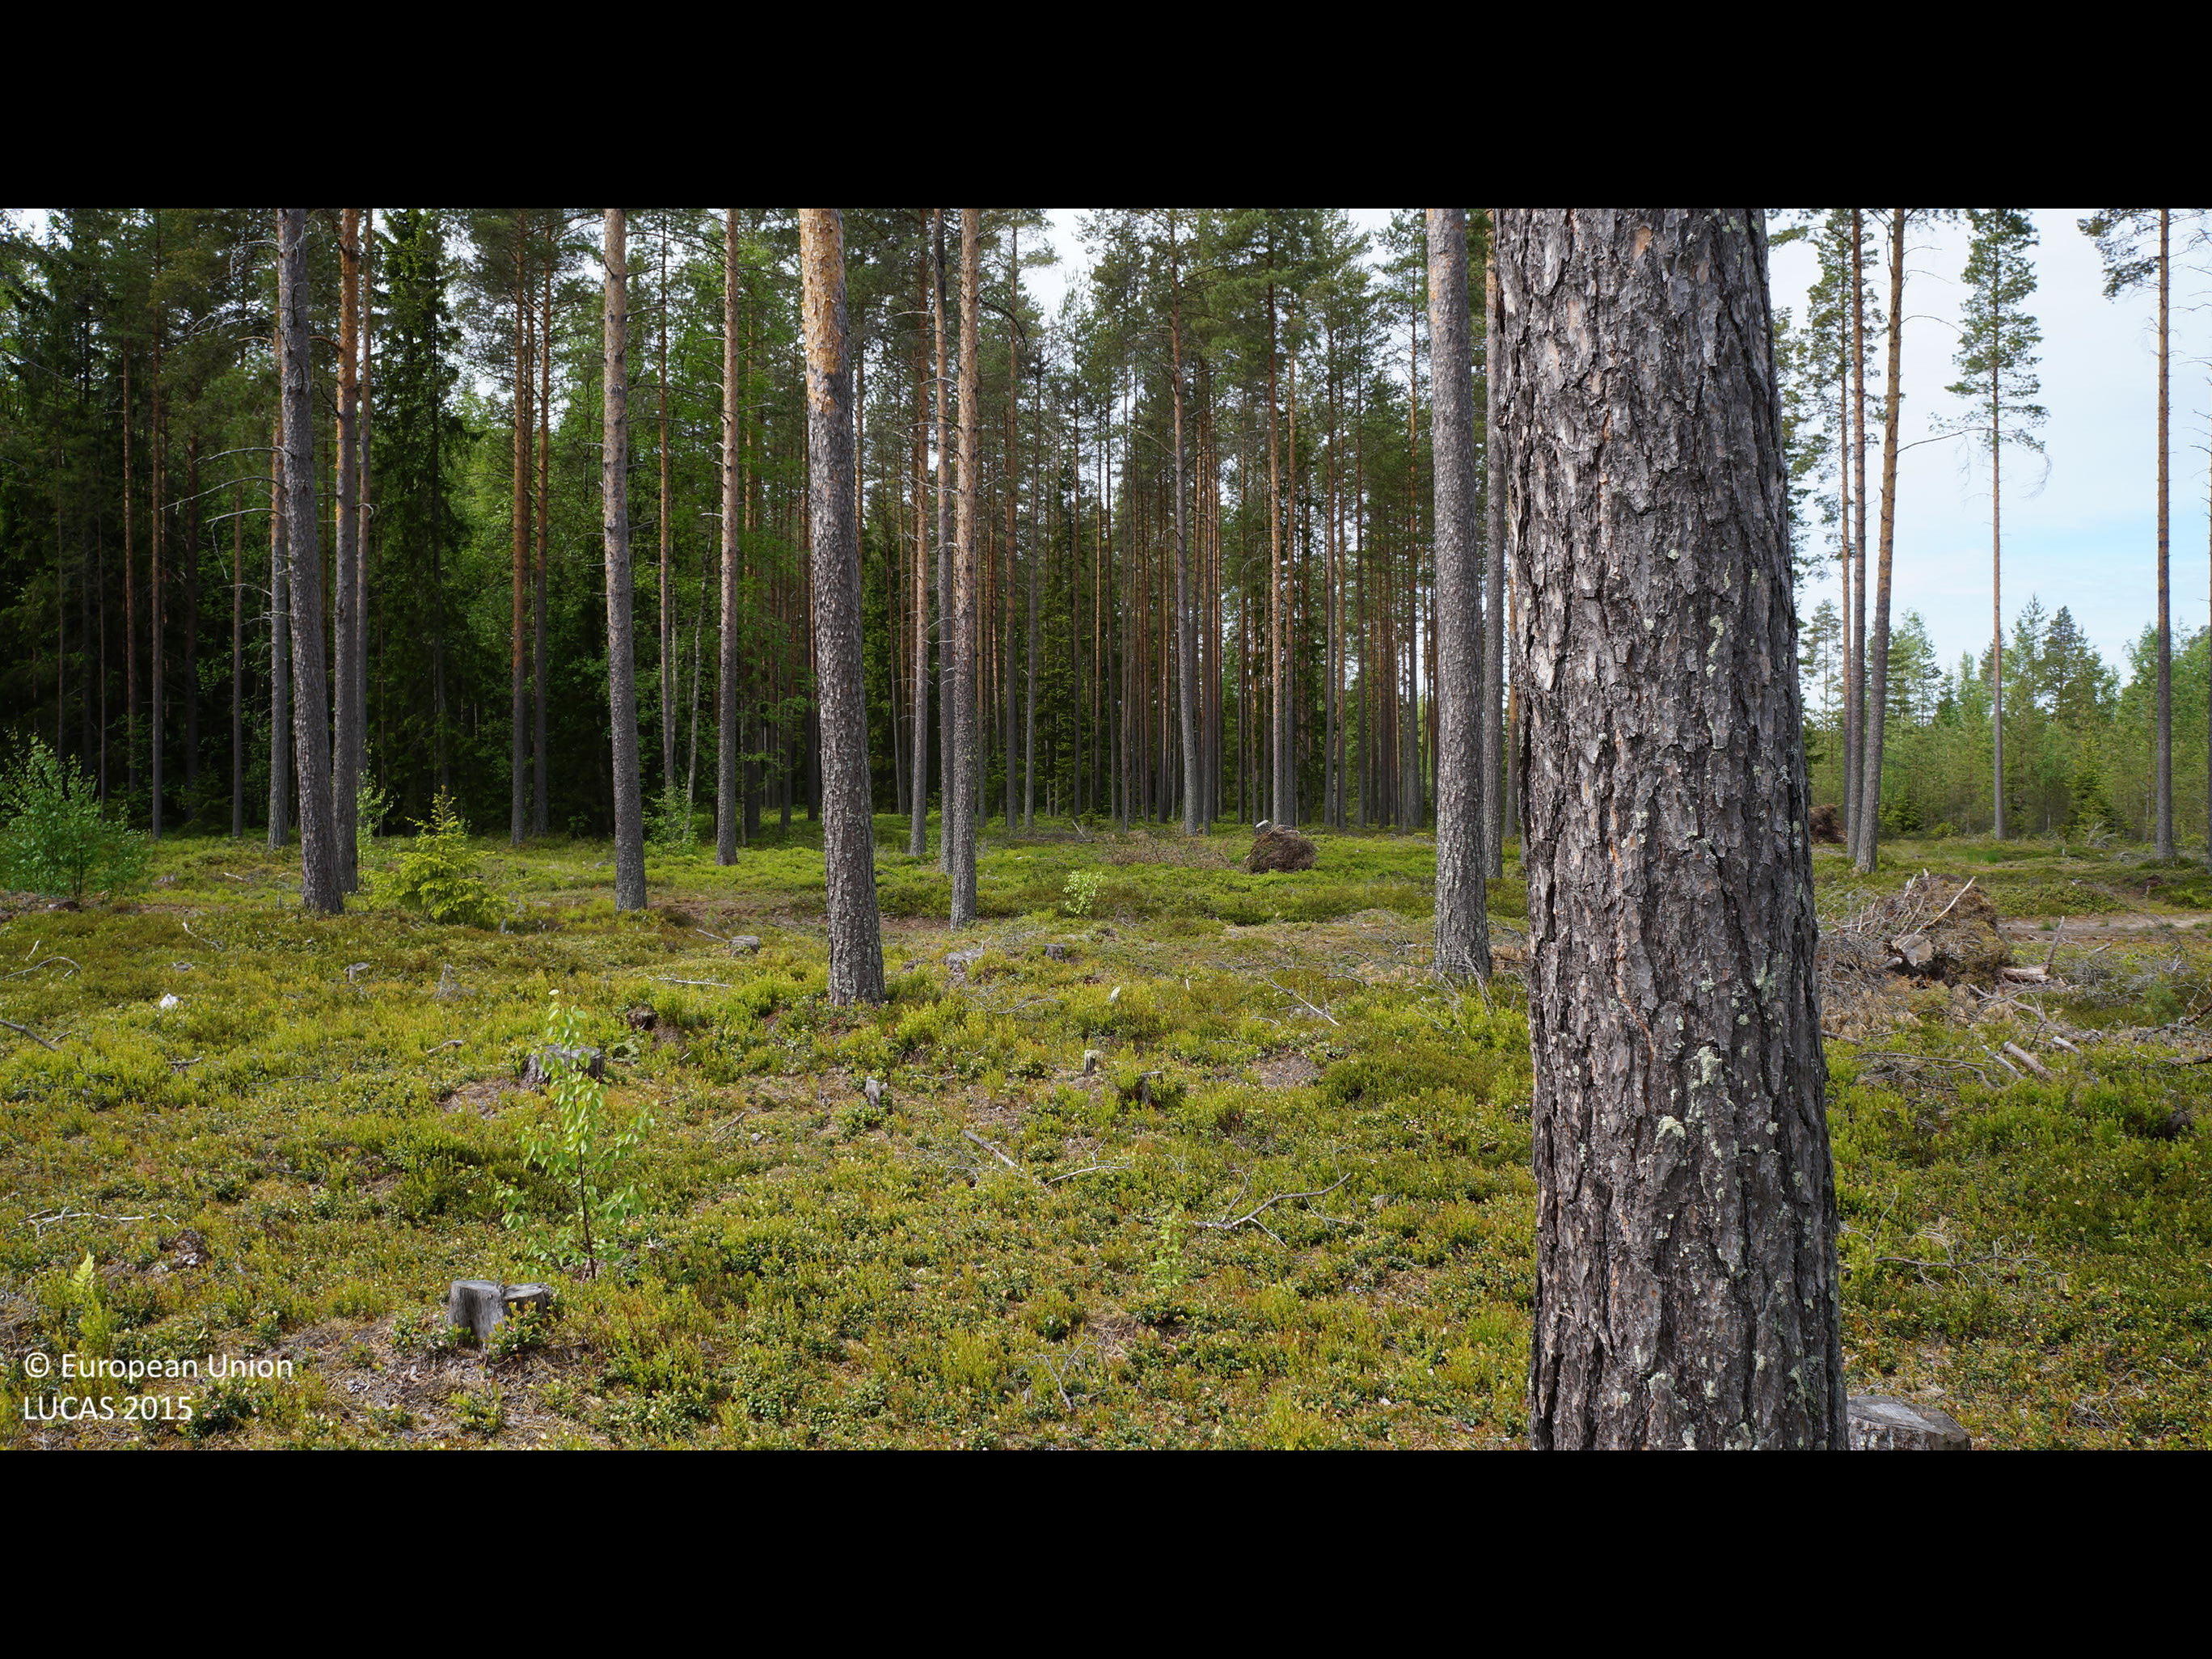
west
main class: Woodland
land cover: Pine dominated coniferous woodland
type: boreal forest
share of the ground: 50 - 75 %
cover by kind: coniferous forest trees 70 %, herbaceous plants 15 %, shrubs 10 %, lichens and mosses 5 %
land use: Forestry
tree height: > 5 m
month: June
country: FI
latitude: 63.9707
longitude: 23.4343
